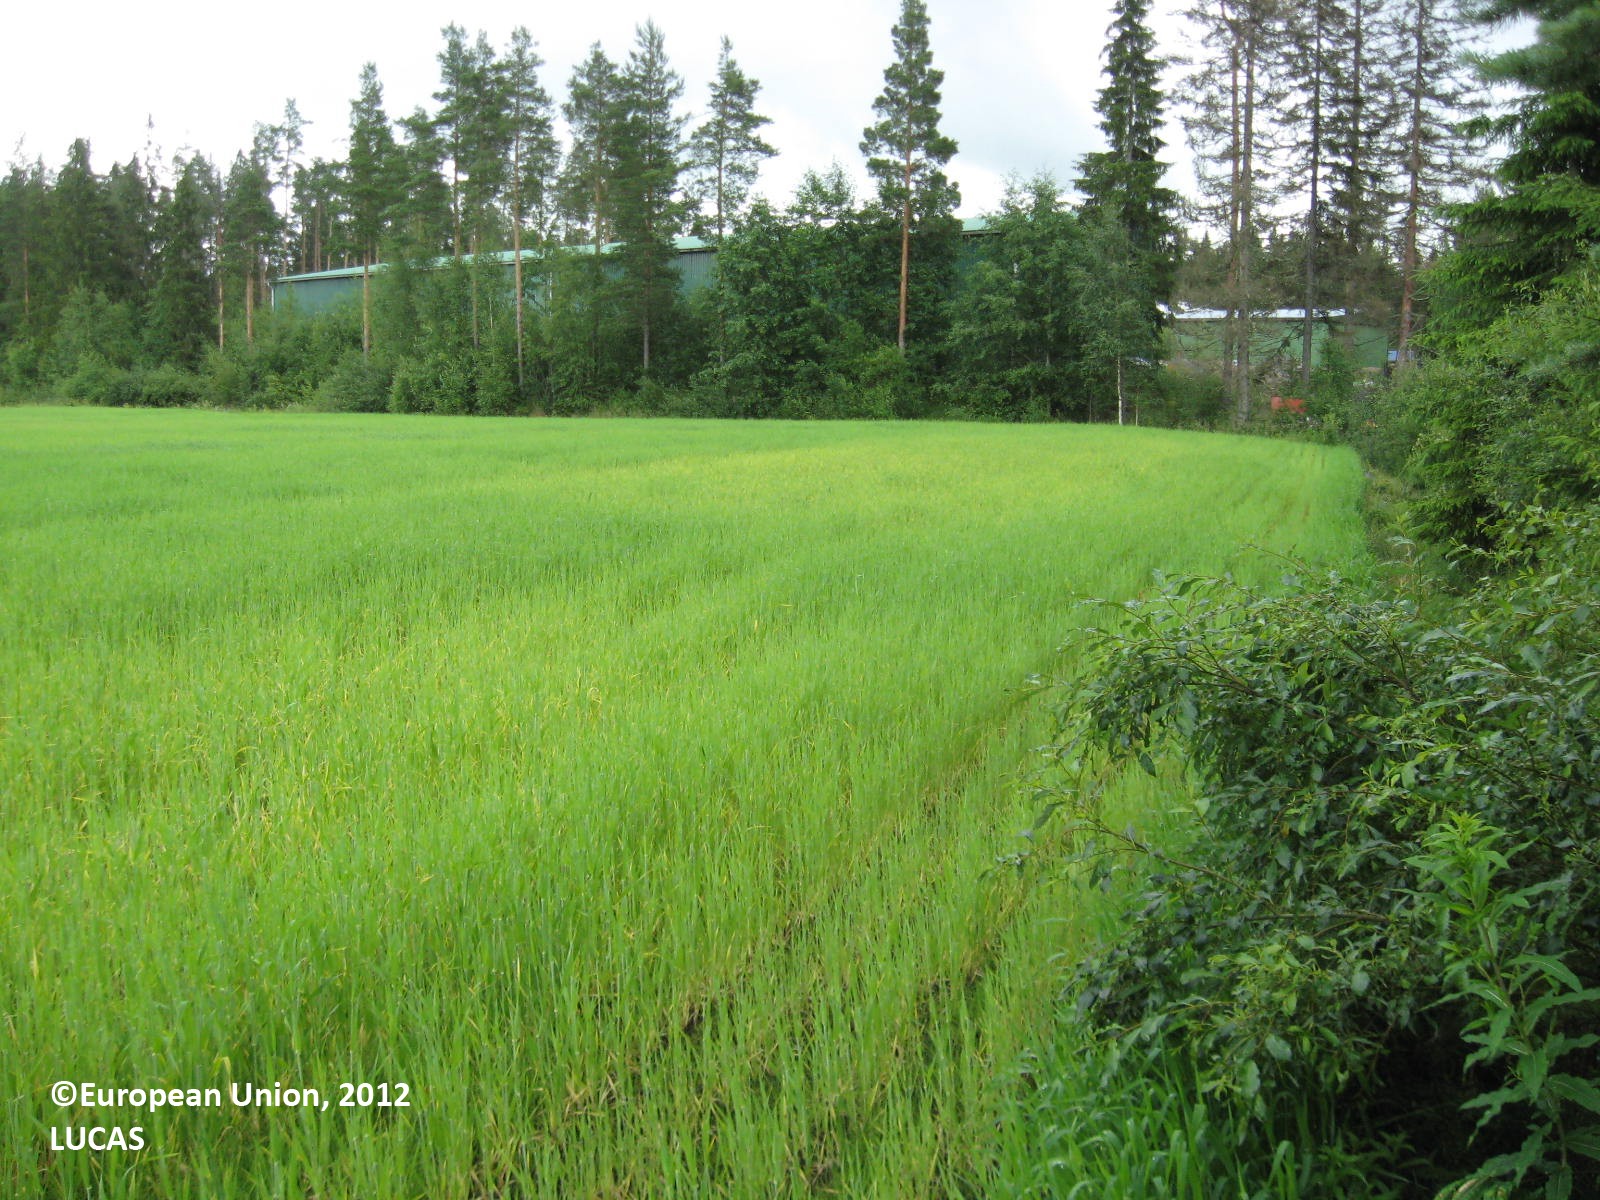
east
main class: Cropland
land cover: Barley
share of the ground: > 75 %
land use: Agriculture (excluding fallow land and kitchen gardens)
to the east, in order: Barley; Shruby margins; Ditches and canals; Other coniferous woodland; Ditches and canals; Other coniferous woodland; Ditches and canals; Electric lines; Grass margins; Barley
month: July
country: FI
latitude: 62.3536
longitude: 22.8309
